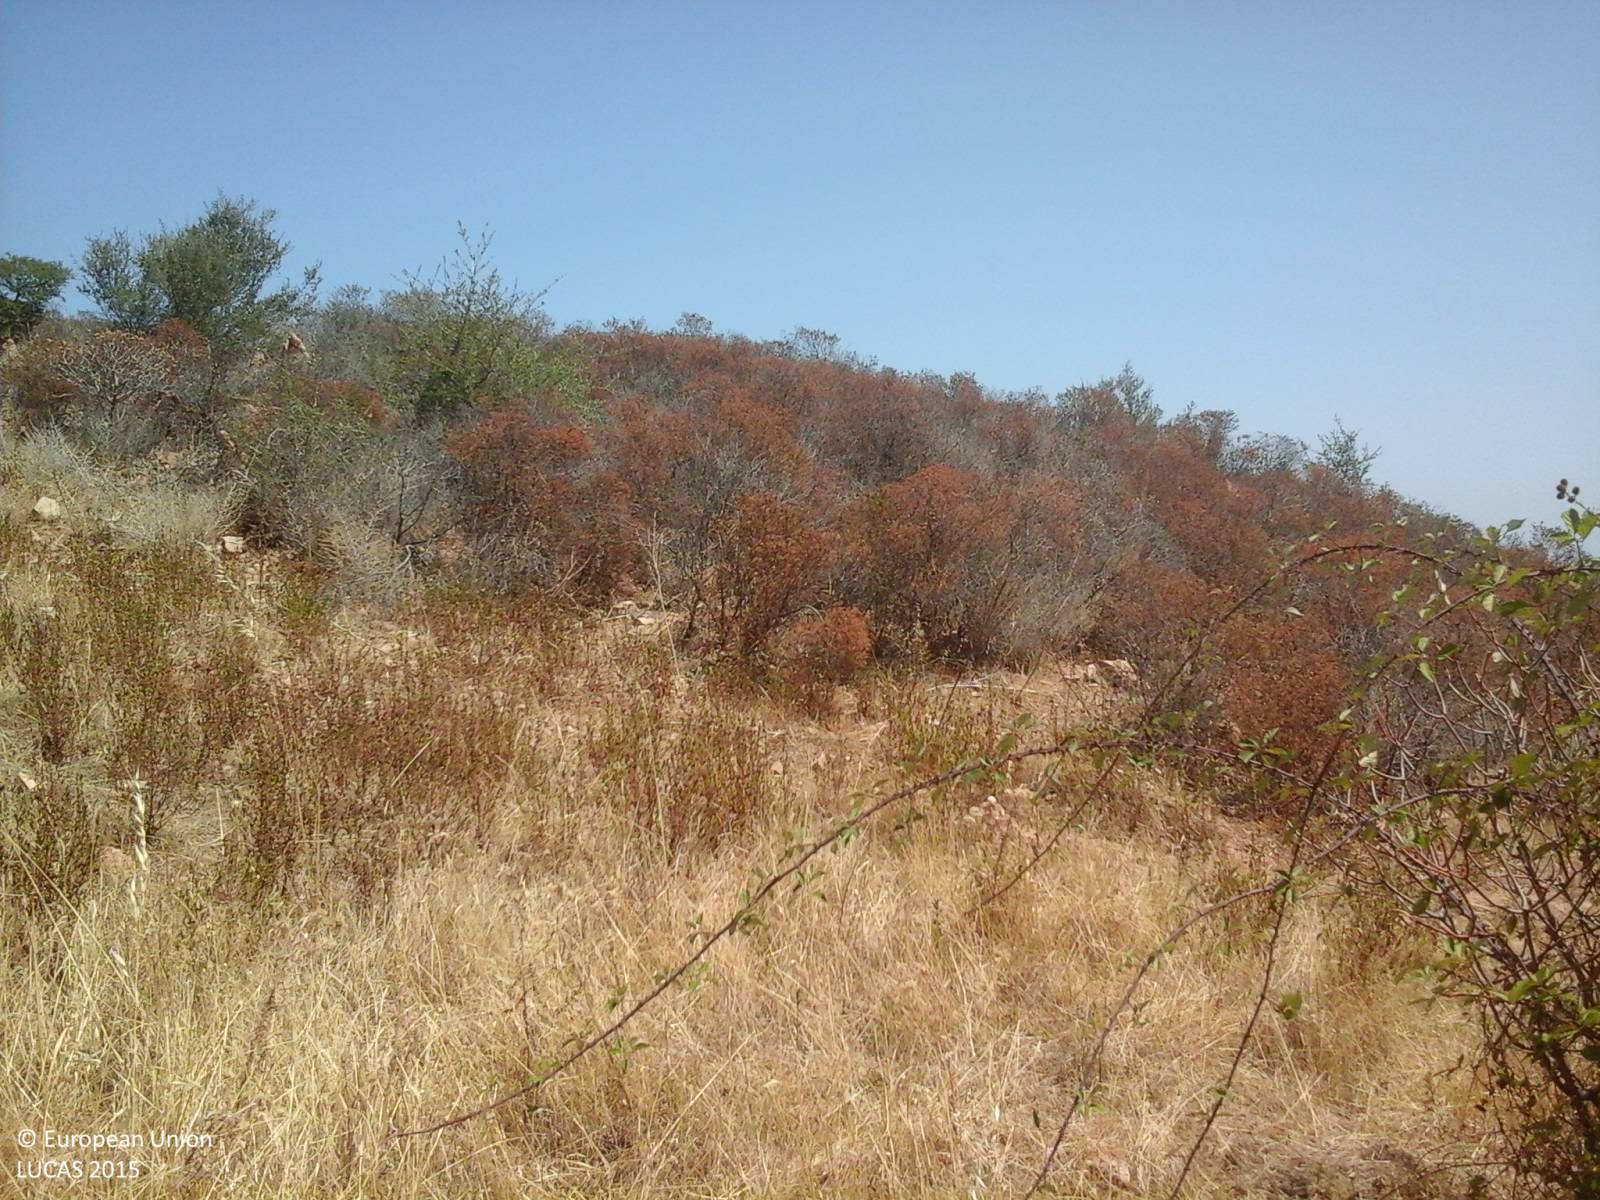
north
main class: Shrubland
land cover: Shrubland without tree cover
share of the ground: > 75 %
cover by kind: shrubs 90 %, herbaceous plants 5 %, unconsolidated bare surface 5 %
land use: Agriculture (excluding fallow land and kitchen gardens)
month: July
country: IT
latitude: 40.8637
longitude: 9.5867
